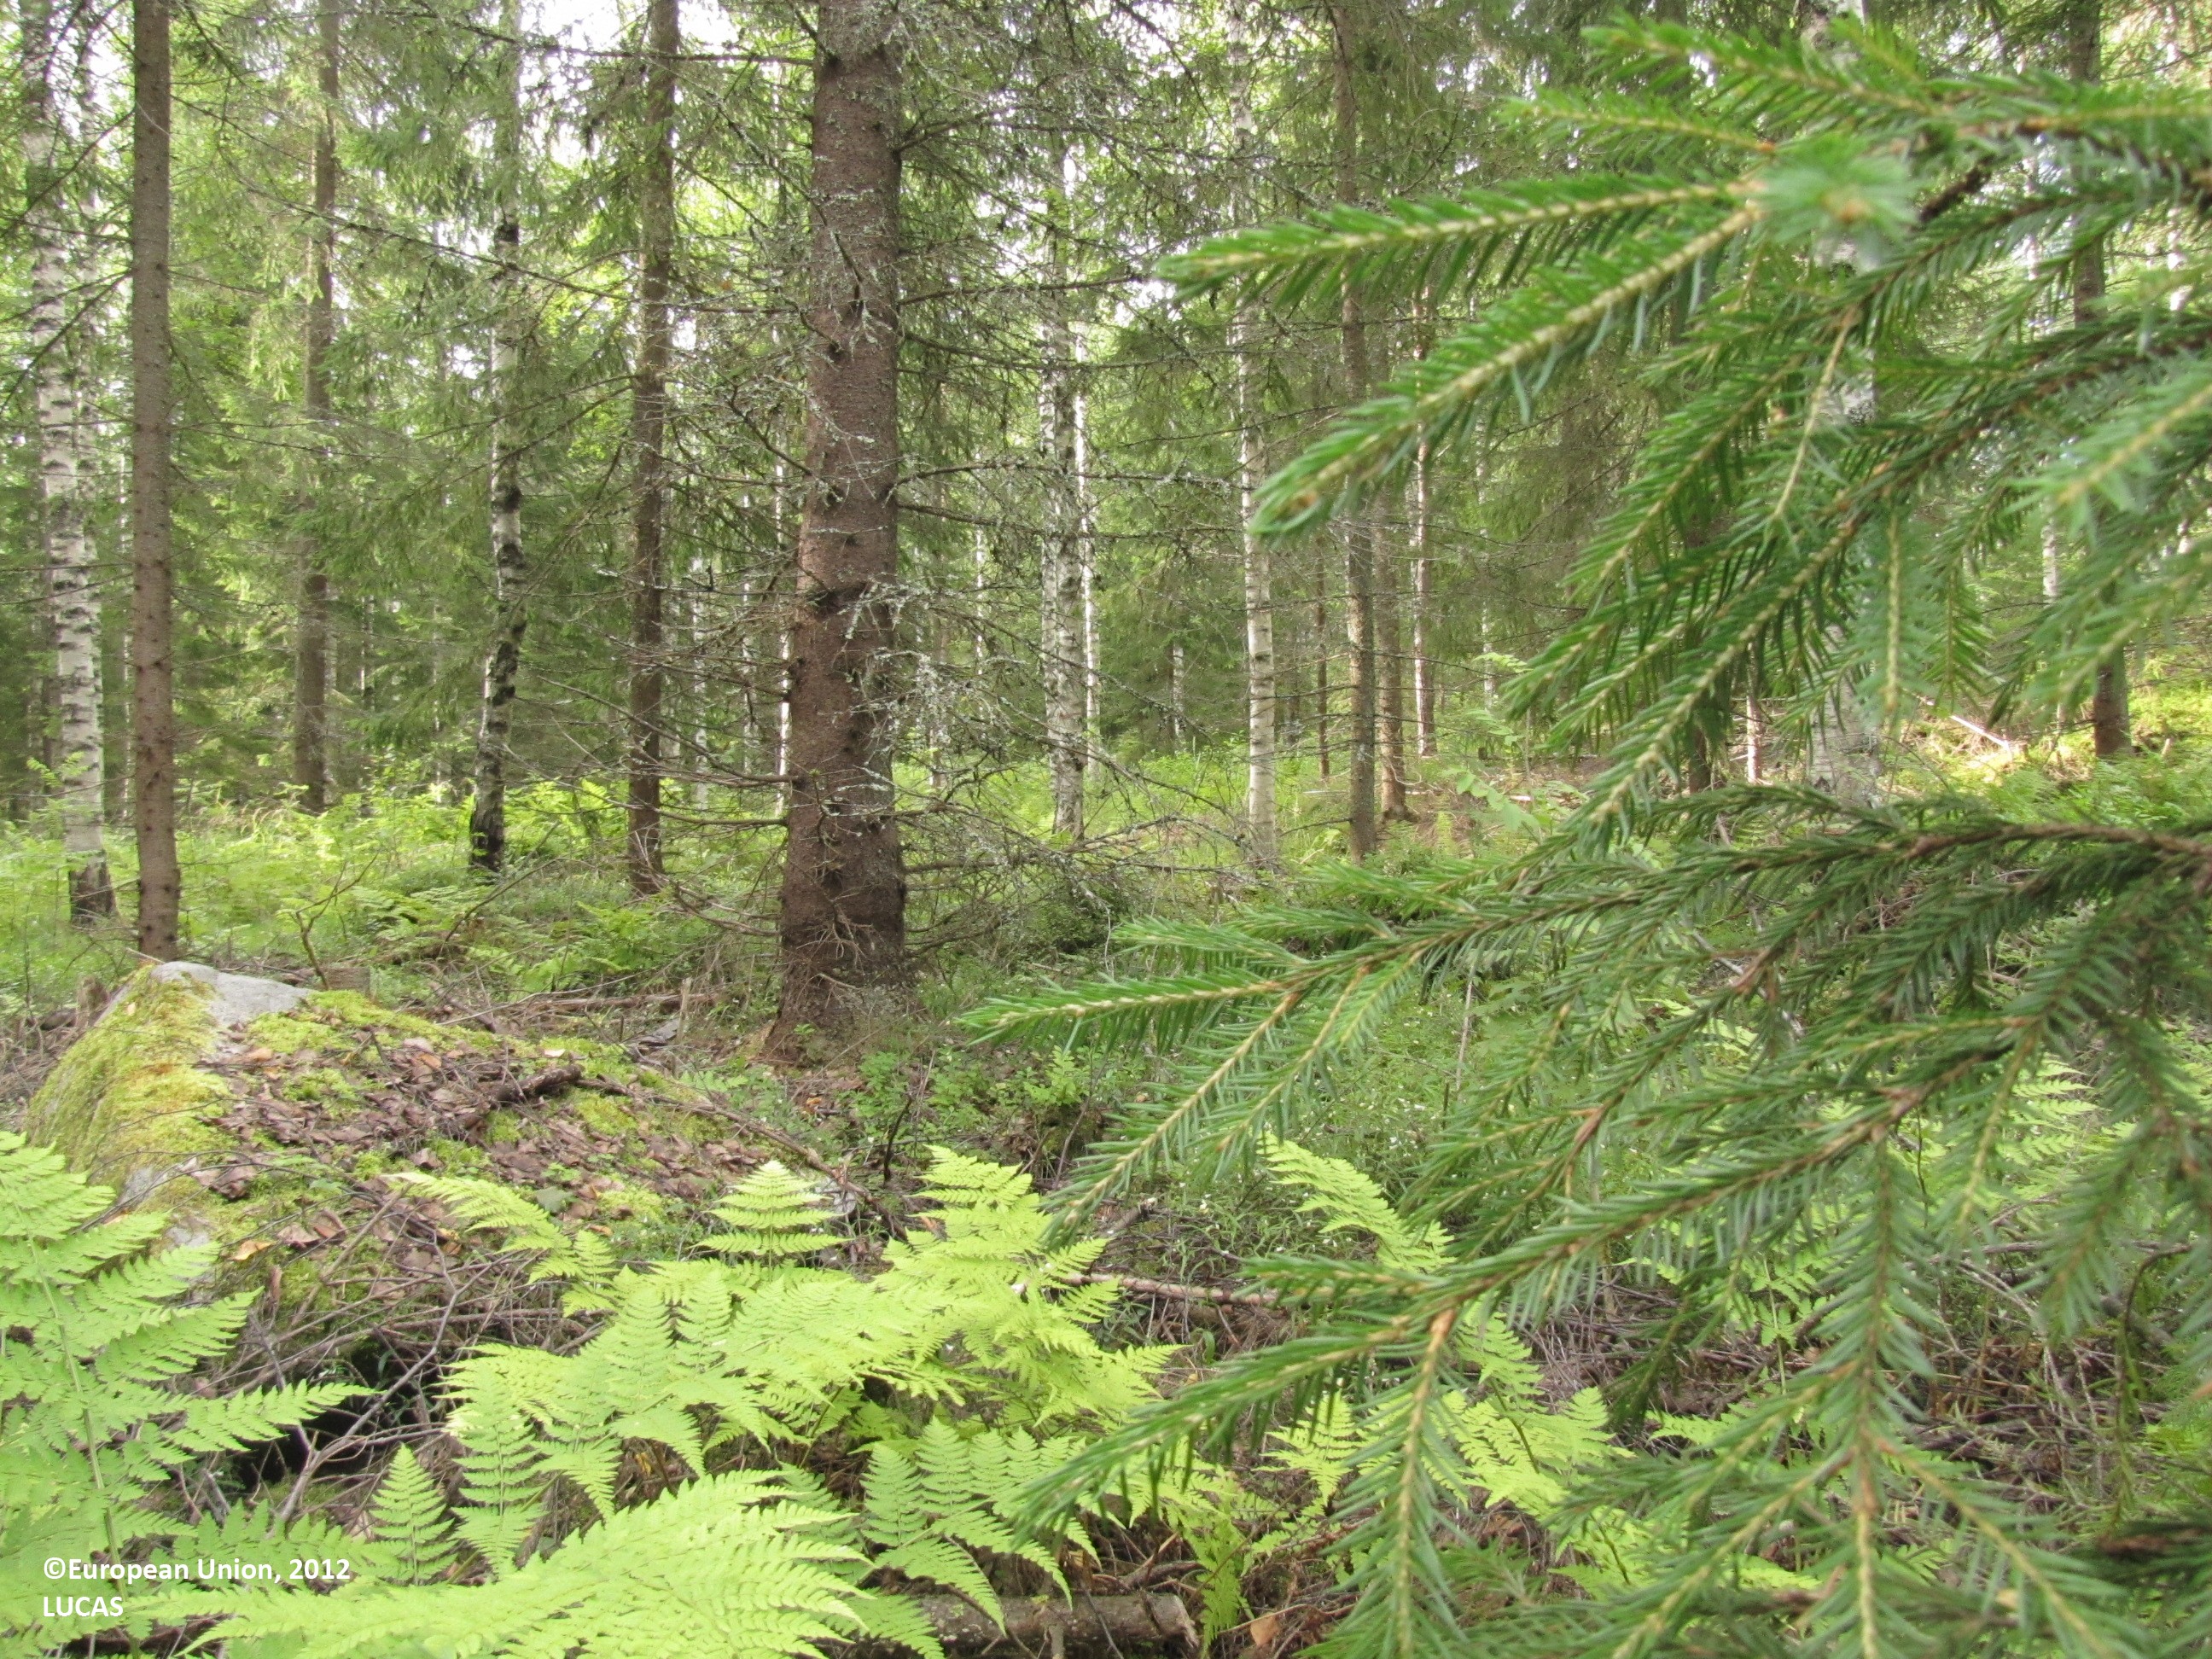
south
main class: Woodland
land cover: Other mixed woodland
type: boreal forest
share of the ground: 50 - 75 %
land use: Forestry
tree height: > 5 m
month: August
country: FI
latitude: 61.8956
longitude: 23.8401
